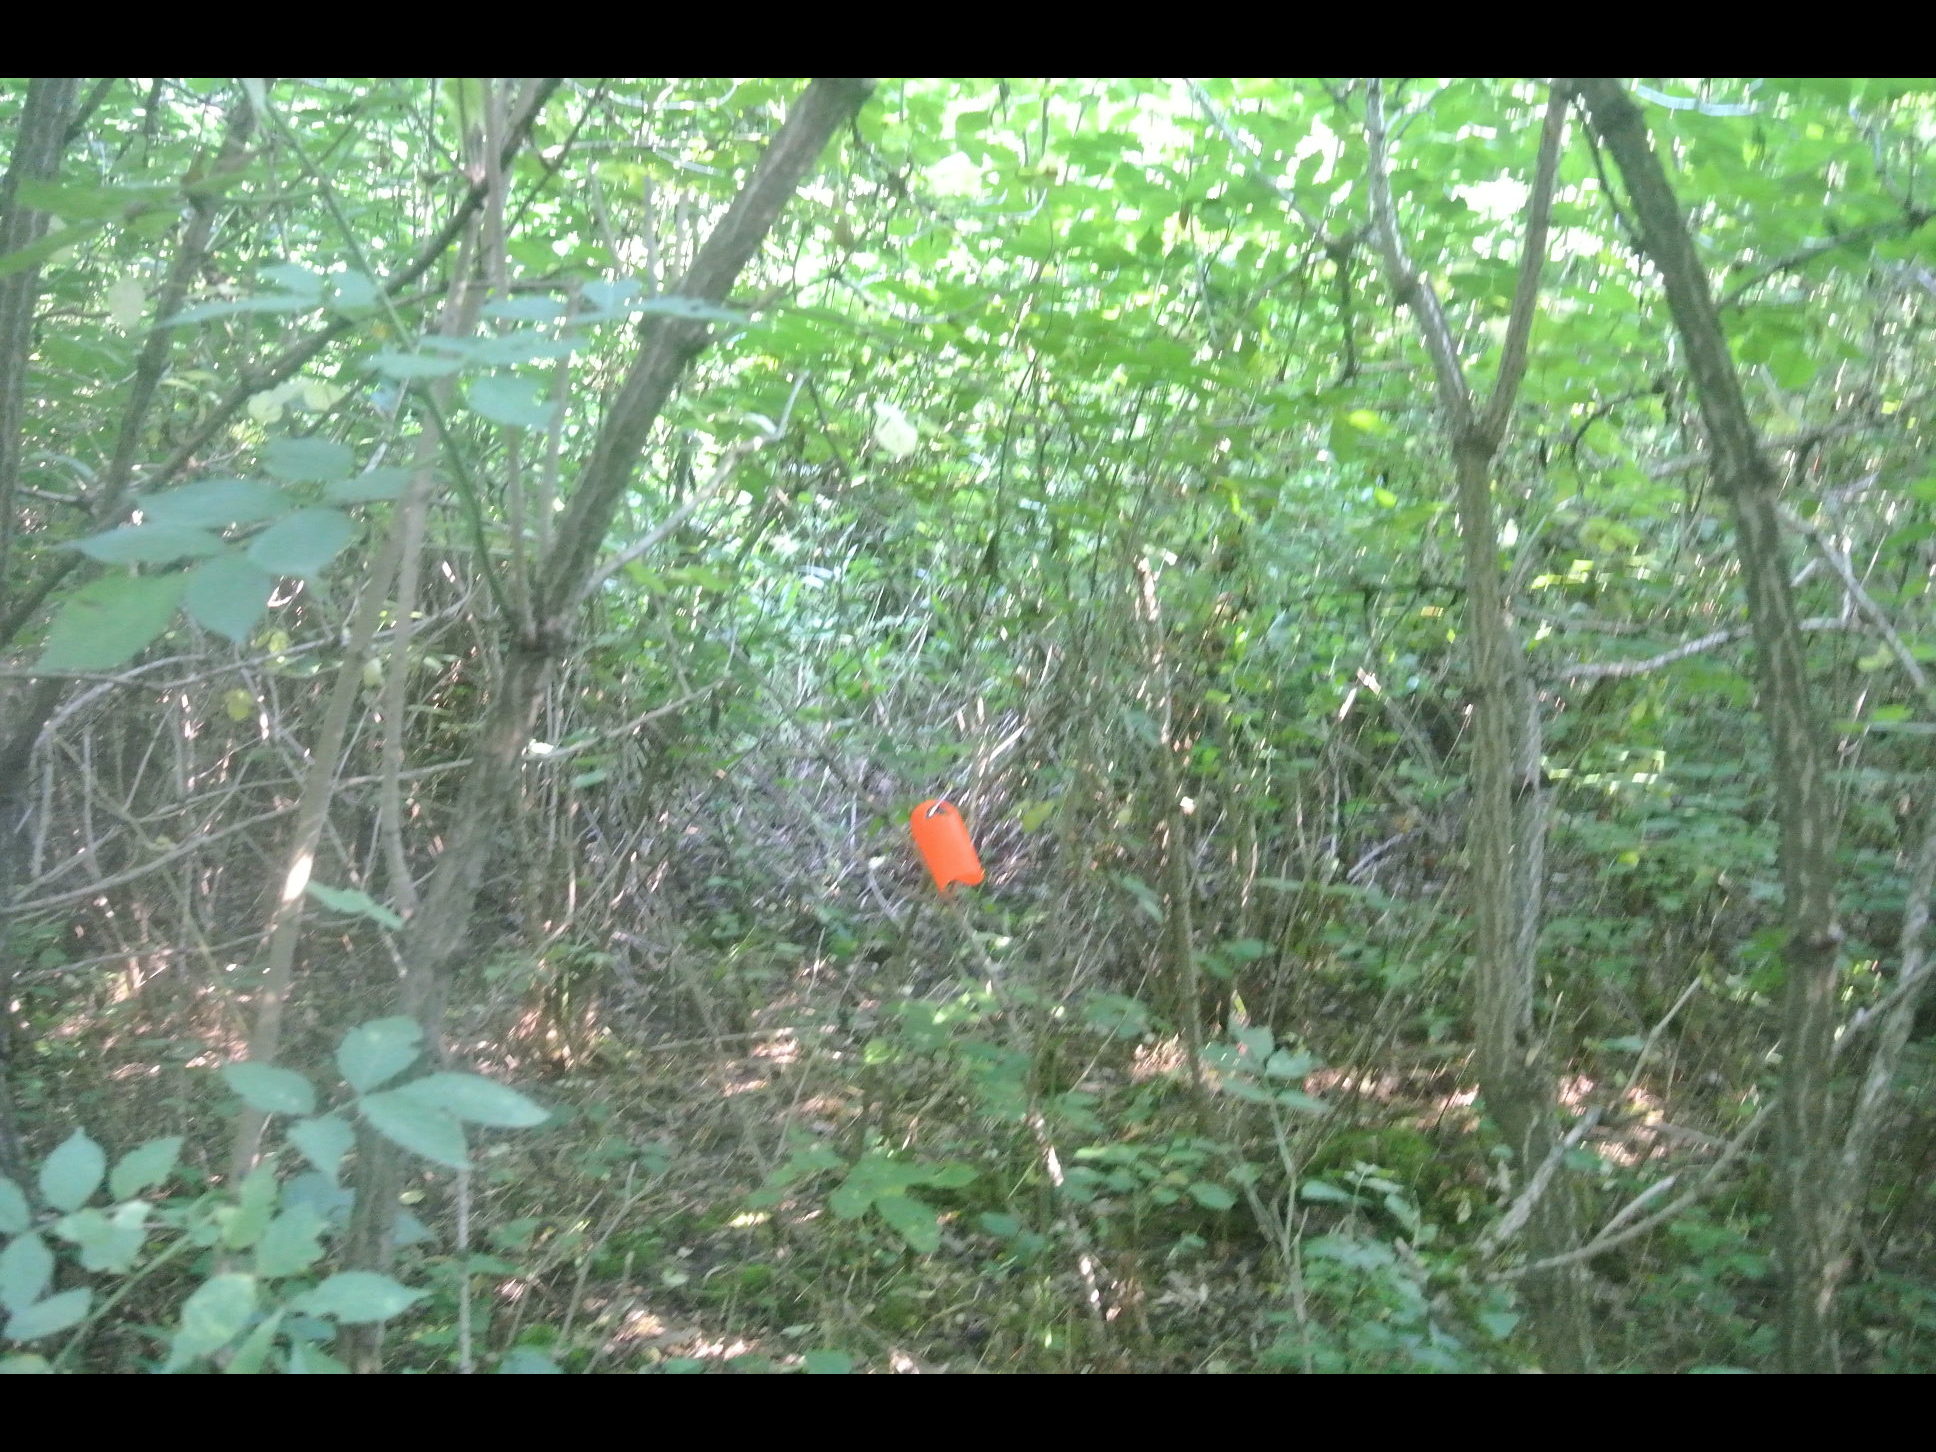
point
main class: Woodland
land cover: Broadleaved woodland
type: exotic forest
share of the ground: > 75 %
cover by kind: broadleaved forest trees 100 %
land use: Forestry
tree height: > 5 m
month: July
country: AT
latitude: 47.5652
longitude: 16.4502
